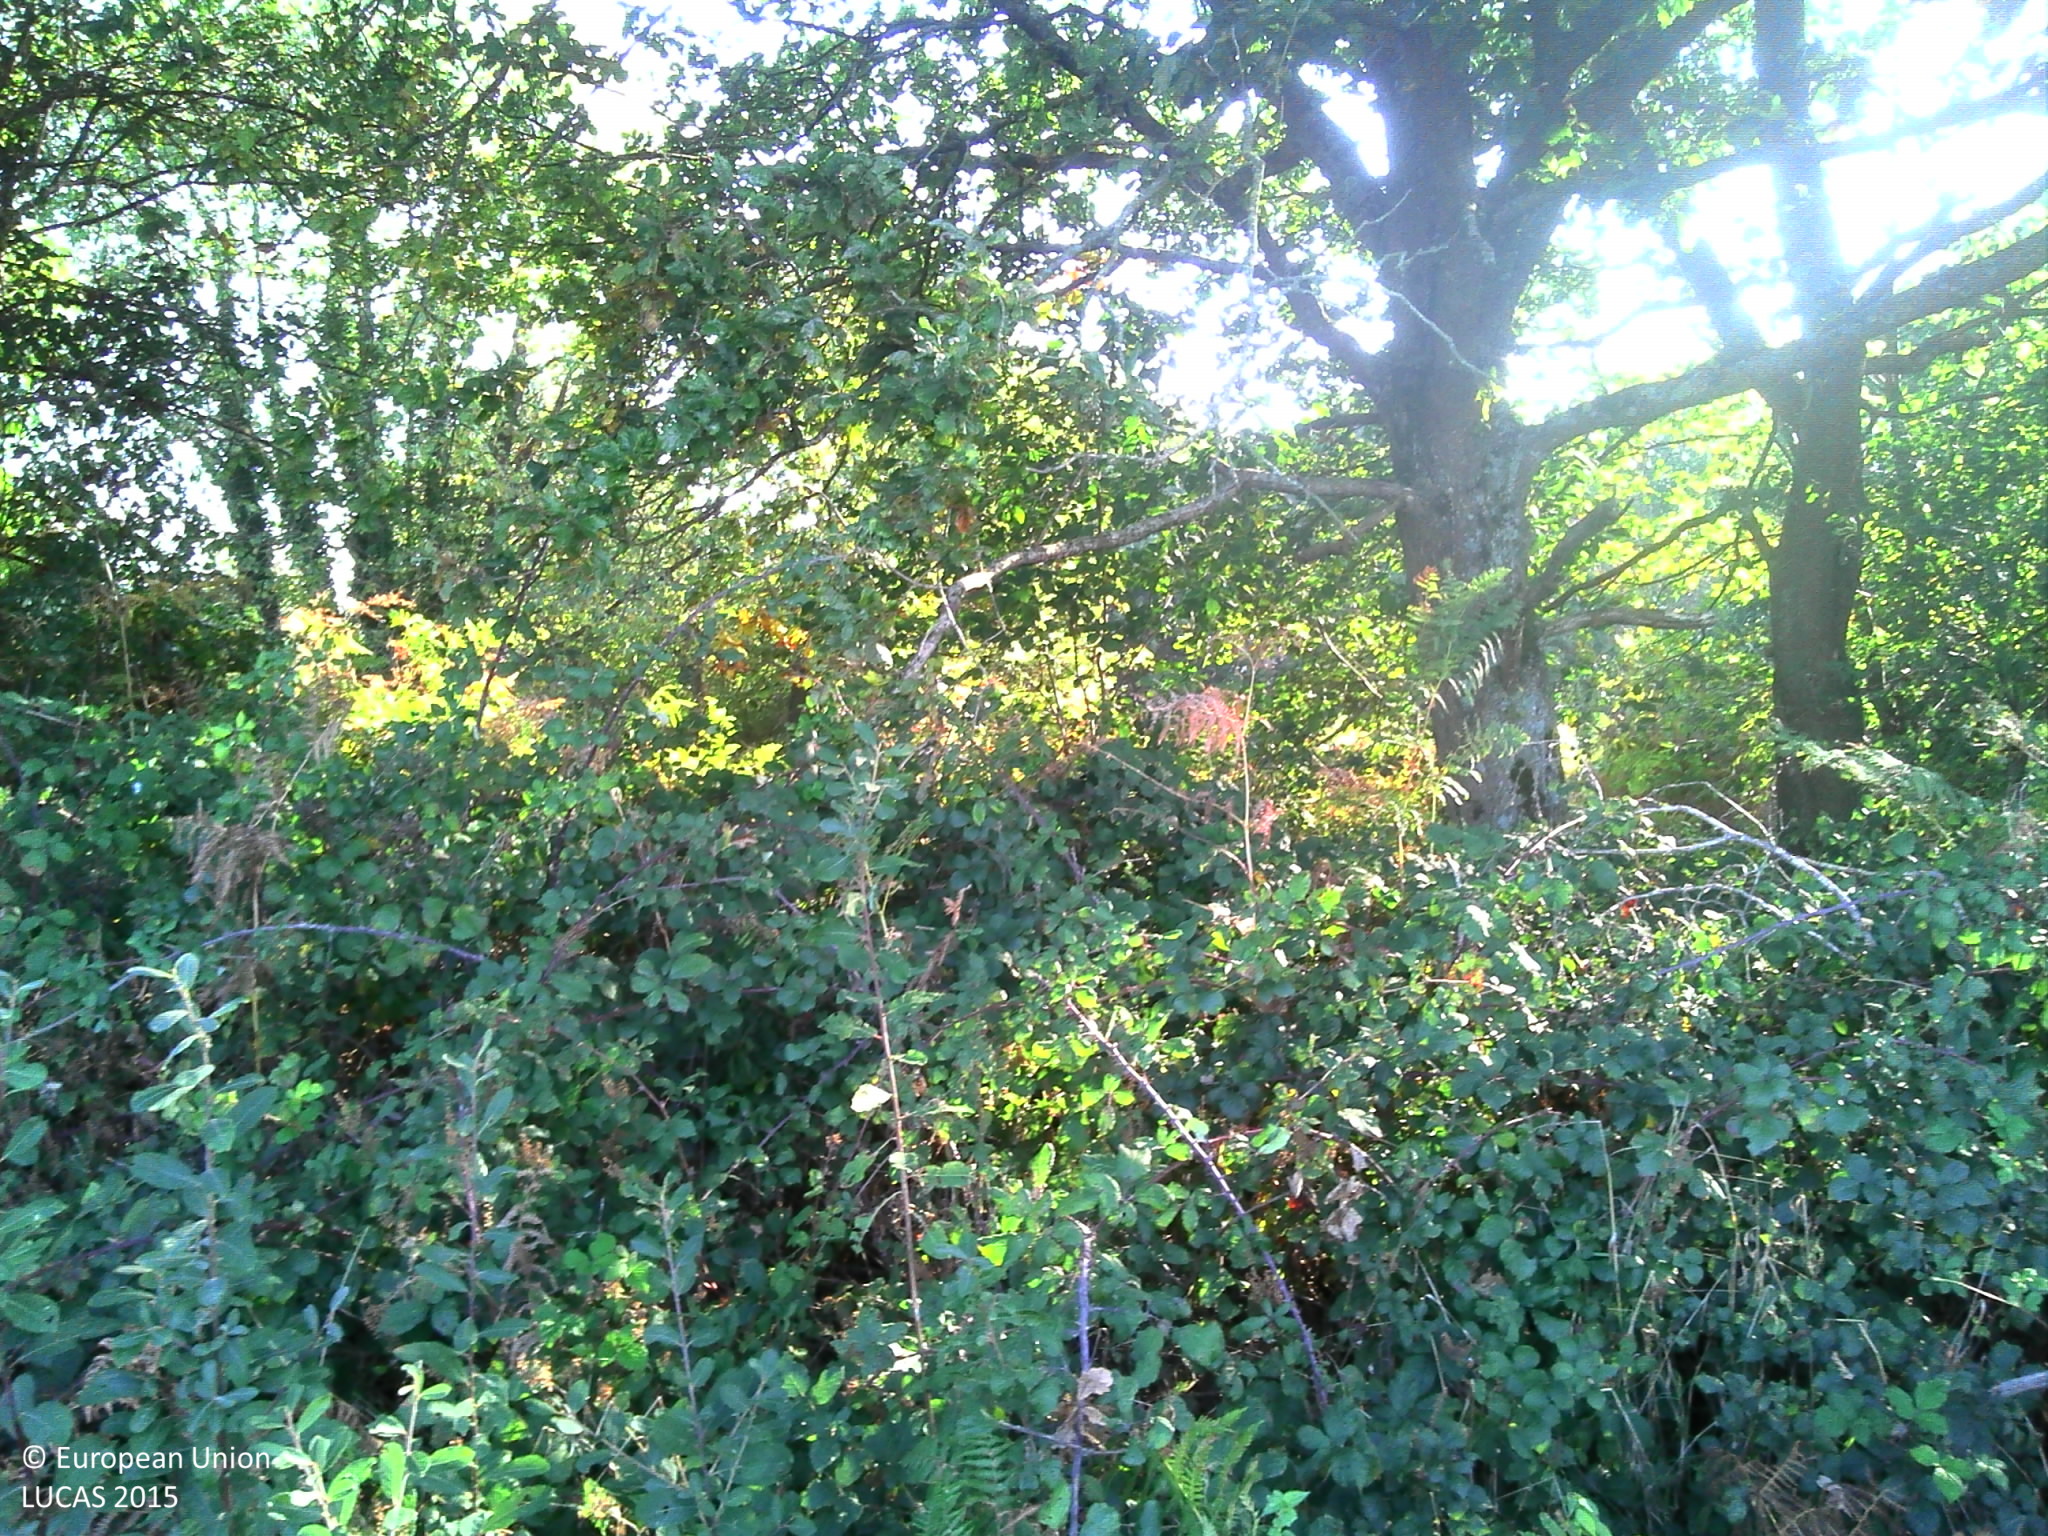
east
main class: Woodland
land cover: Broadleaved woodland
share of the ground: > 75 %
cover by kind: broadleaved forest trees 100 %
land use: Semi-natural and natural areas not in use
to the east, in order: Broadleaved woodland; Spontaneously vegetated surfaces; Broadleaved woodland; Other fibre and oleaginous crops
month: October
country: FR
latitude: 47.7428
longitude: -2.2034
